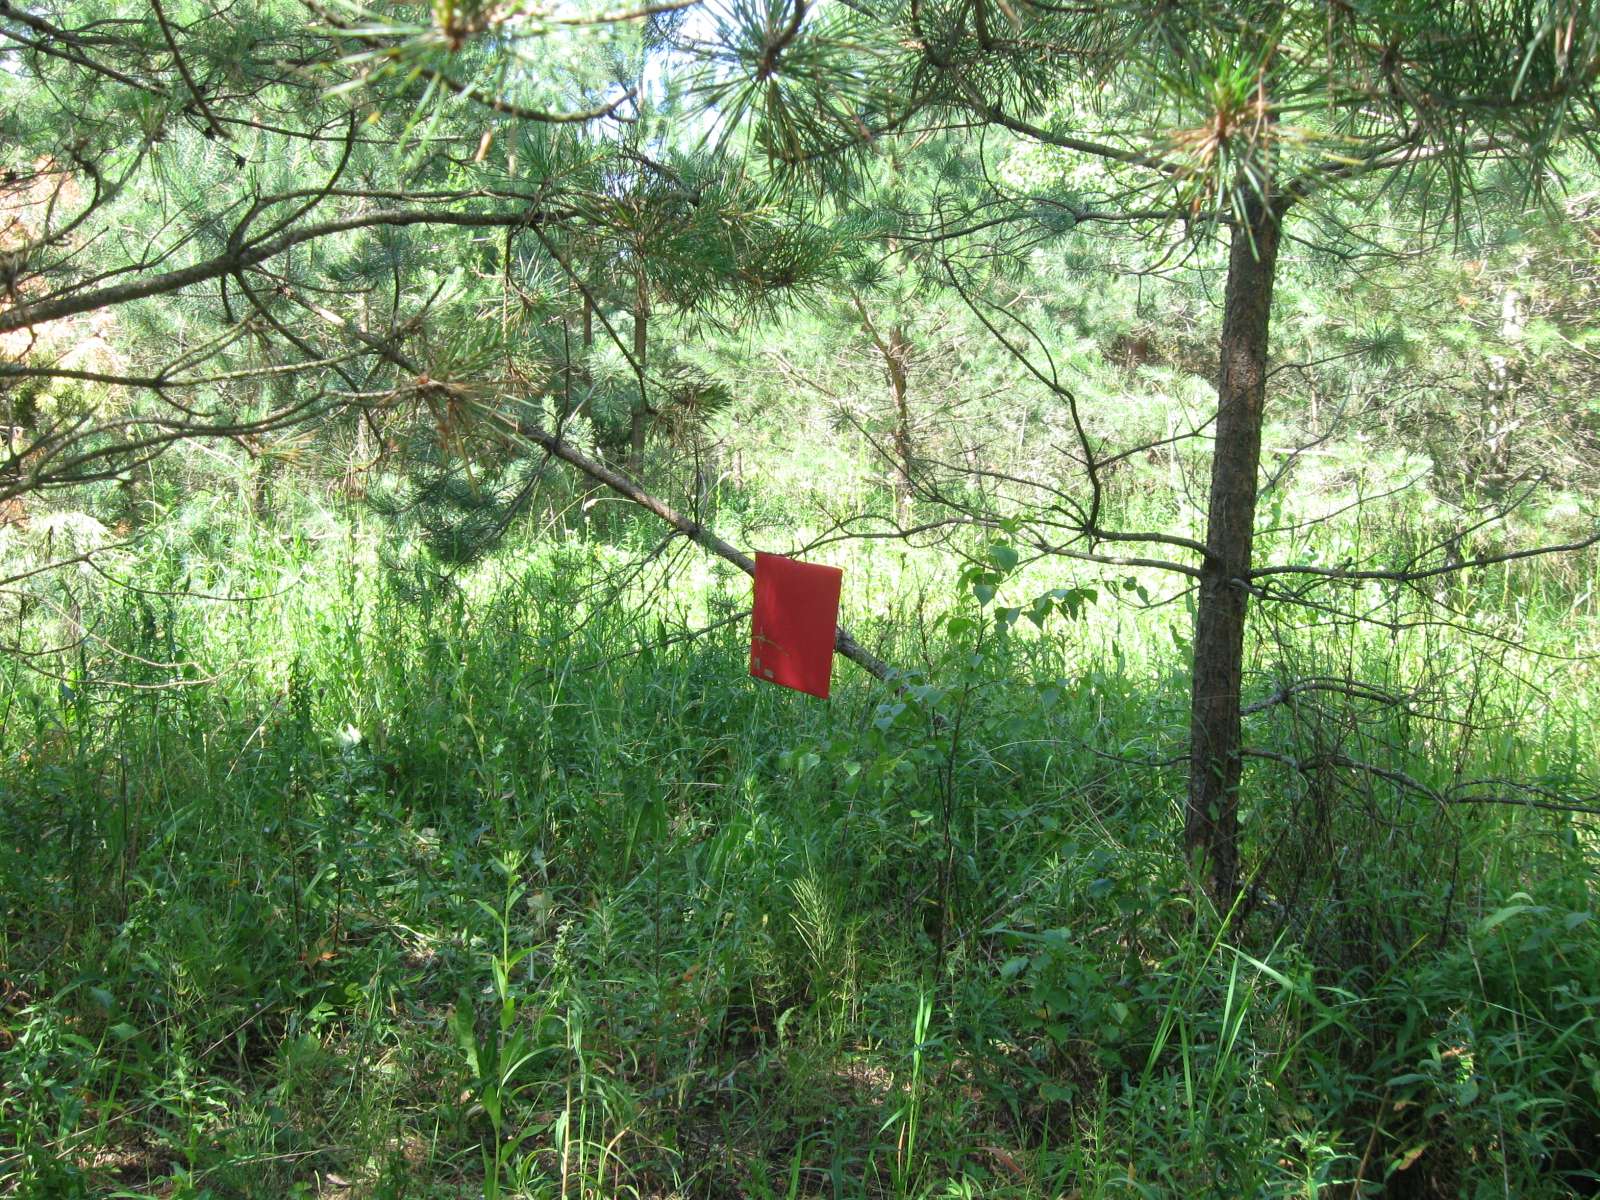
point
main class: Woodland
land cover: Pine dominated mixed woodland
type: hemiboreal forest and nemoral coniferous forest and mixed broadleaved-coniferous forest
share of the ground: > 75 %
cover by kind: coniferous forest trees 50 %, broadleaved forest trees 30 %, herbaceous plants 20 %
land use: Forestry
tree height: > 5 m
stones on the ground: < 10 %
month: July
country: LT
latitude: 54.2126
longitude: 24.2827
